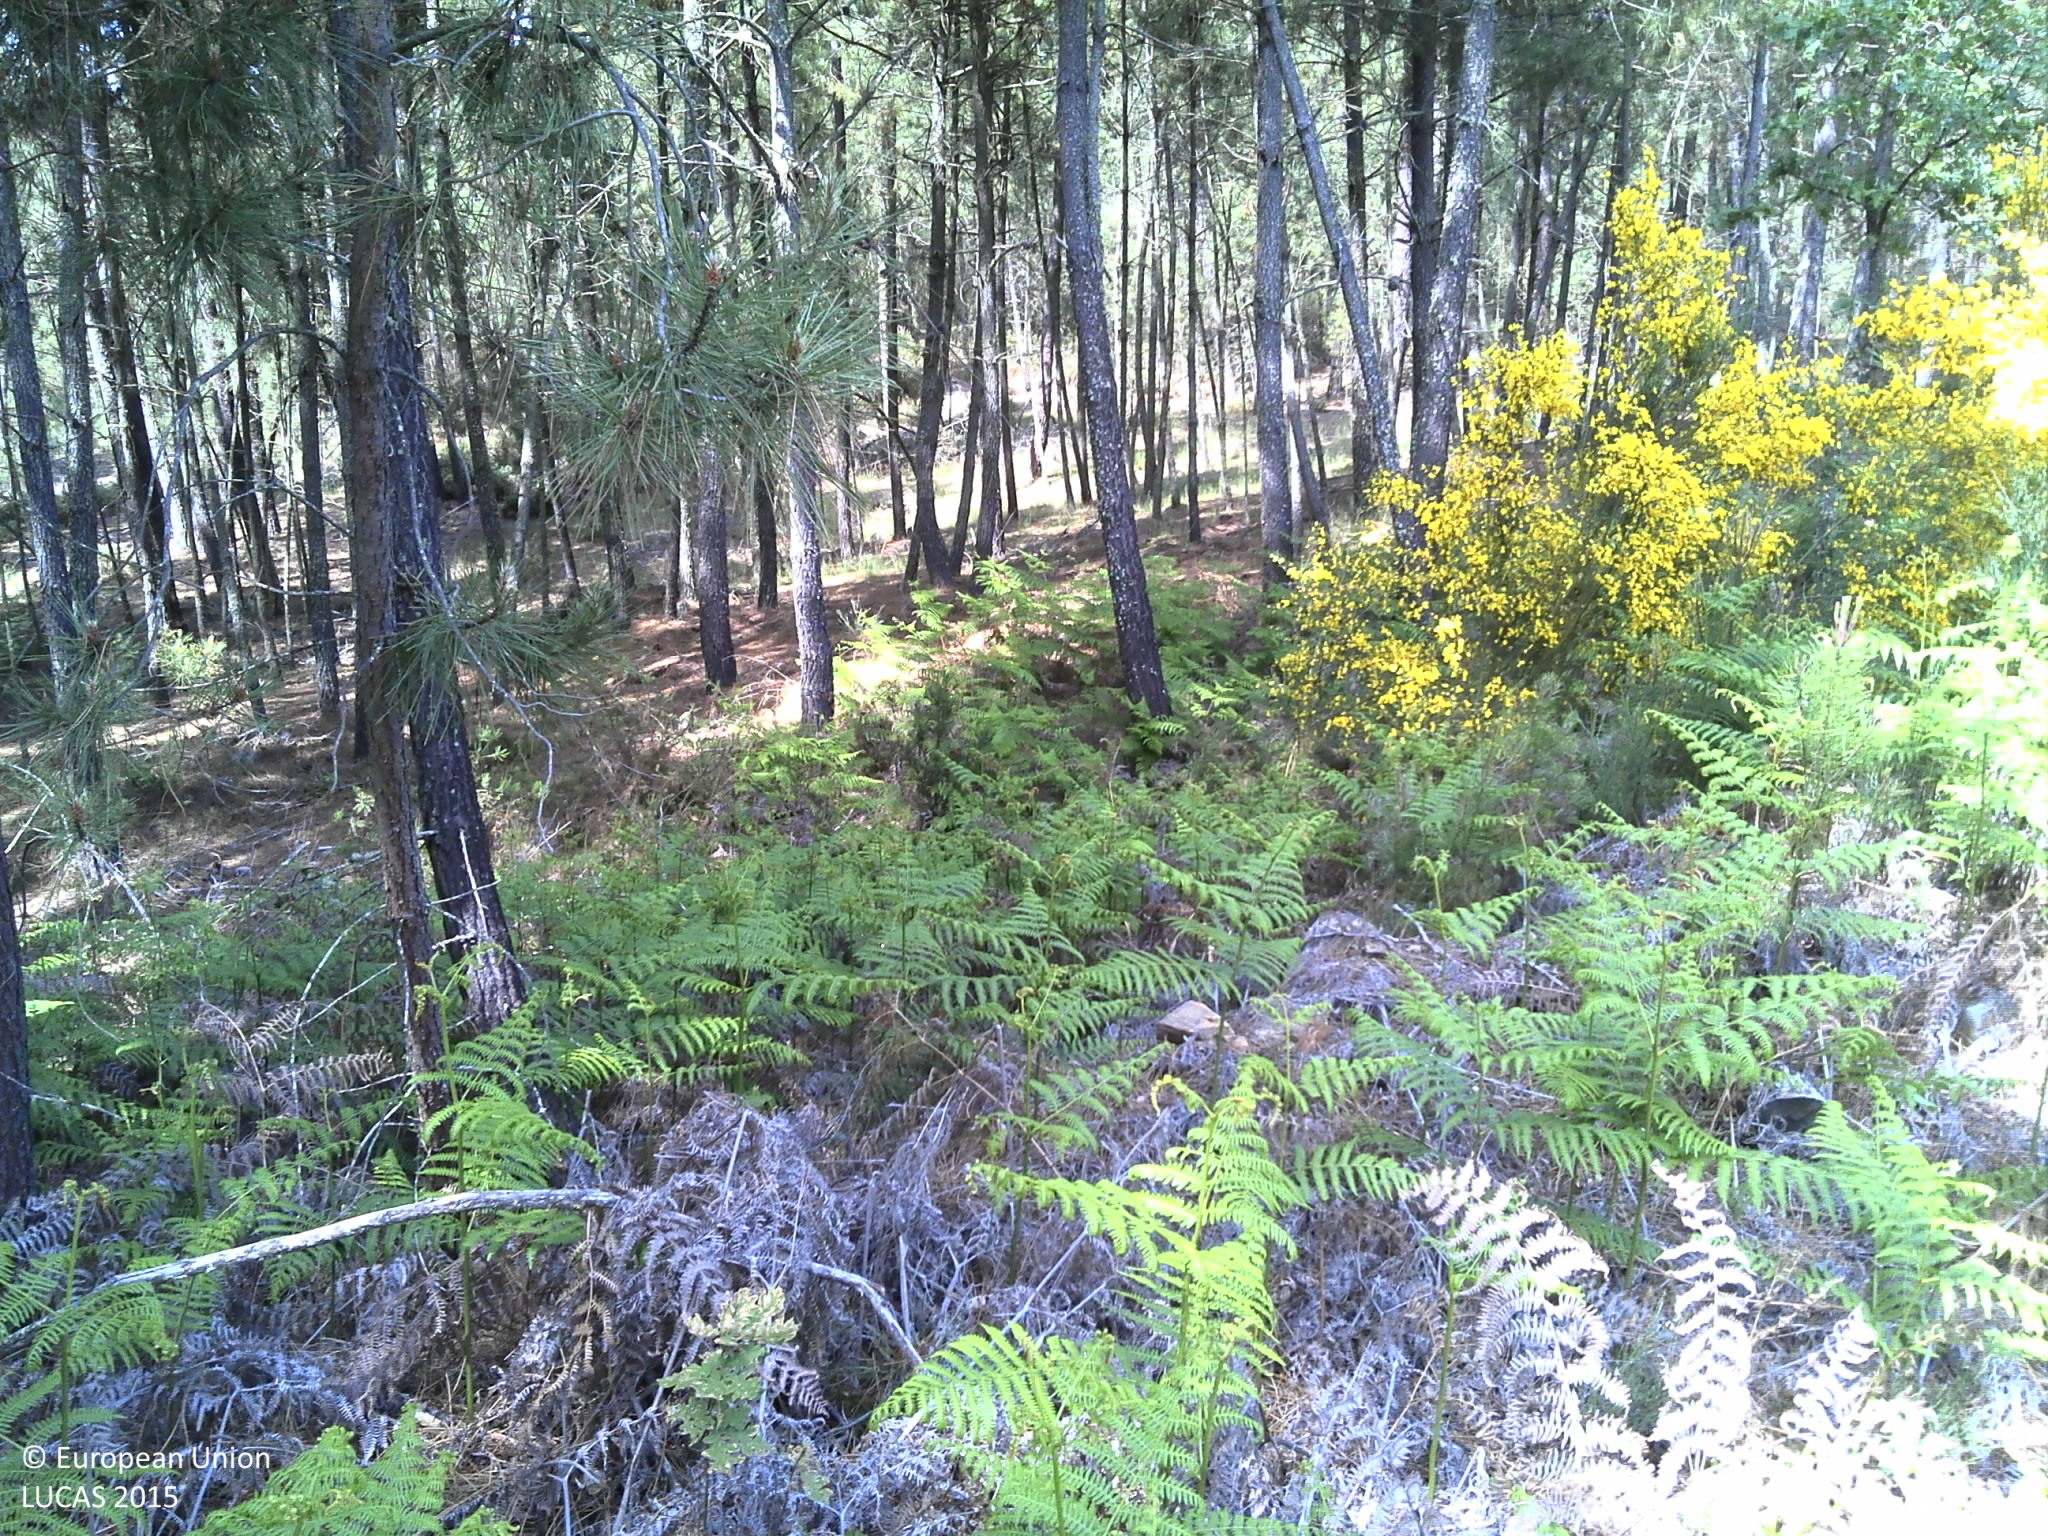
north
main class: Woodland
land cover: Pine dominated coniferous woodland
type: coniferous forest of the mediterranean region
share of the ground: 25 - 50 %
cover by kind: shrubs 60 %, coniferous forest trees 25 %, unconsolidated bare surface 15 %
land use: Forestry
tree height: < 5 m
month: May
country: PT
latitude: 41.6854
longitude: -7.5145
